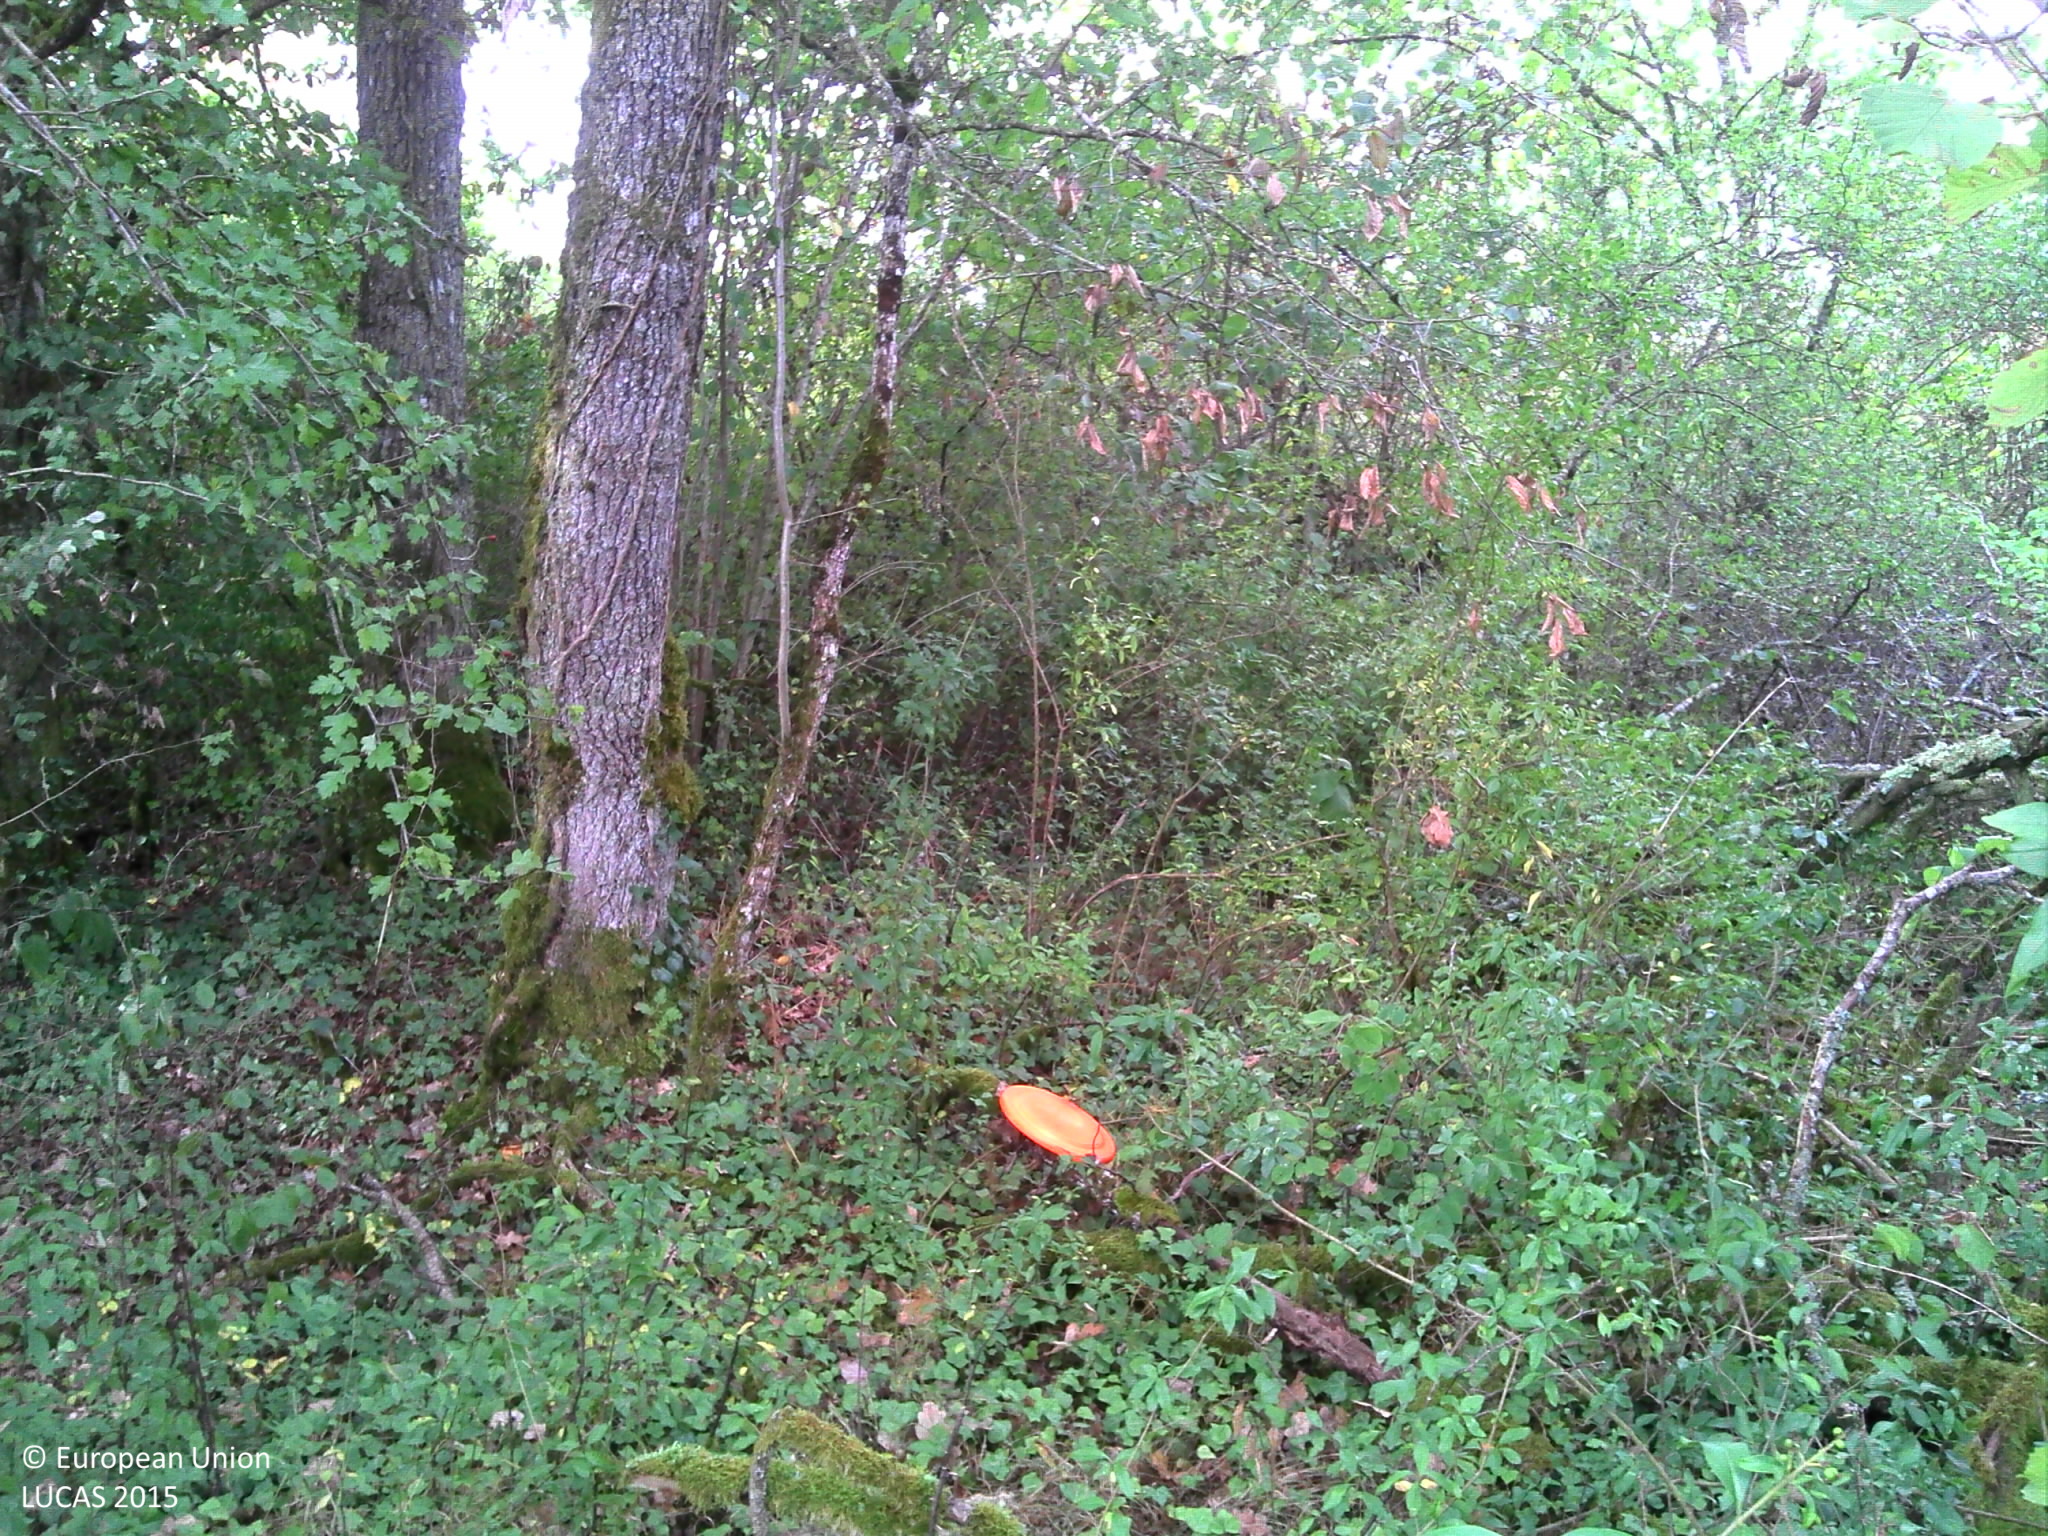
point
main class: Woodland
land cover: Broadleaved woodland
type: mesophytic deciduous forest
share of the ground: > 75 %
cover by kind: broadleaved forest trees 90 %, herbaceous plants 5 %, lichens and mosses 5 %
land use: Forestry
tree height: > 5 m
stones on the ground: 25 - 50 %
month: September
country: FR
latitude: 47.6535
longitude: 4.8737
